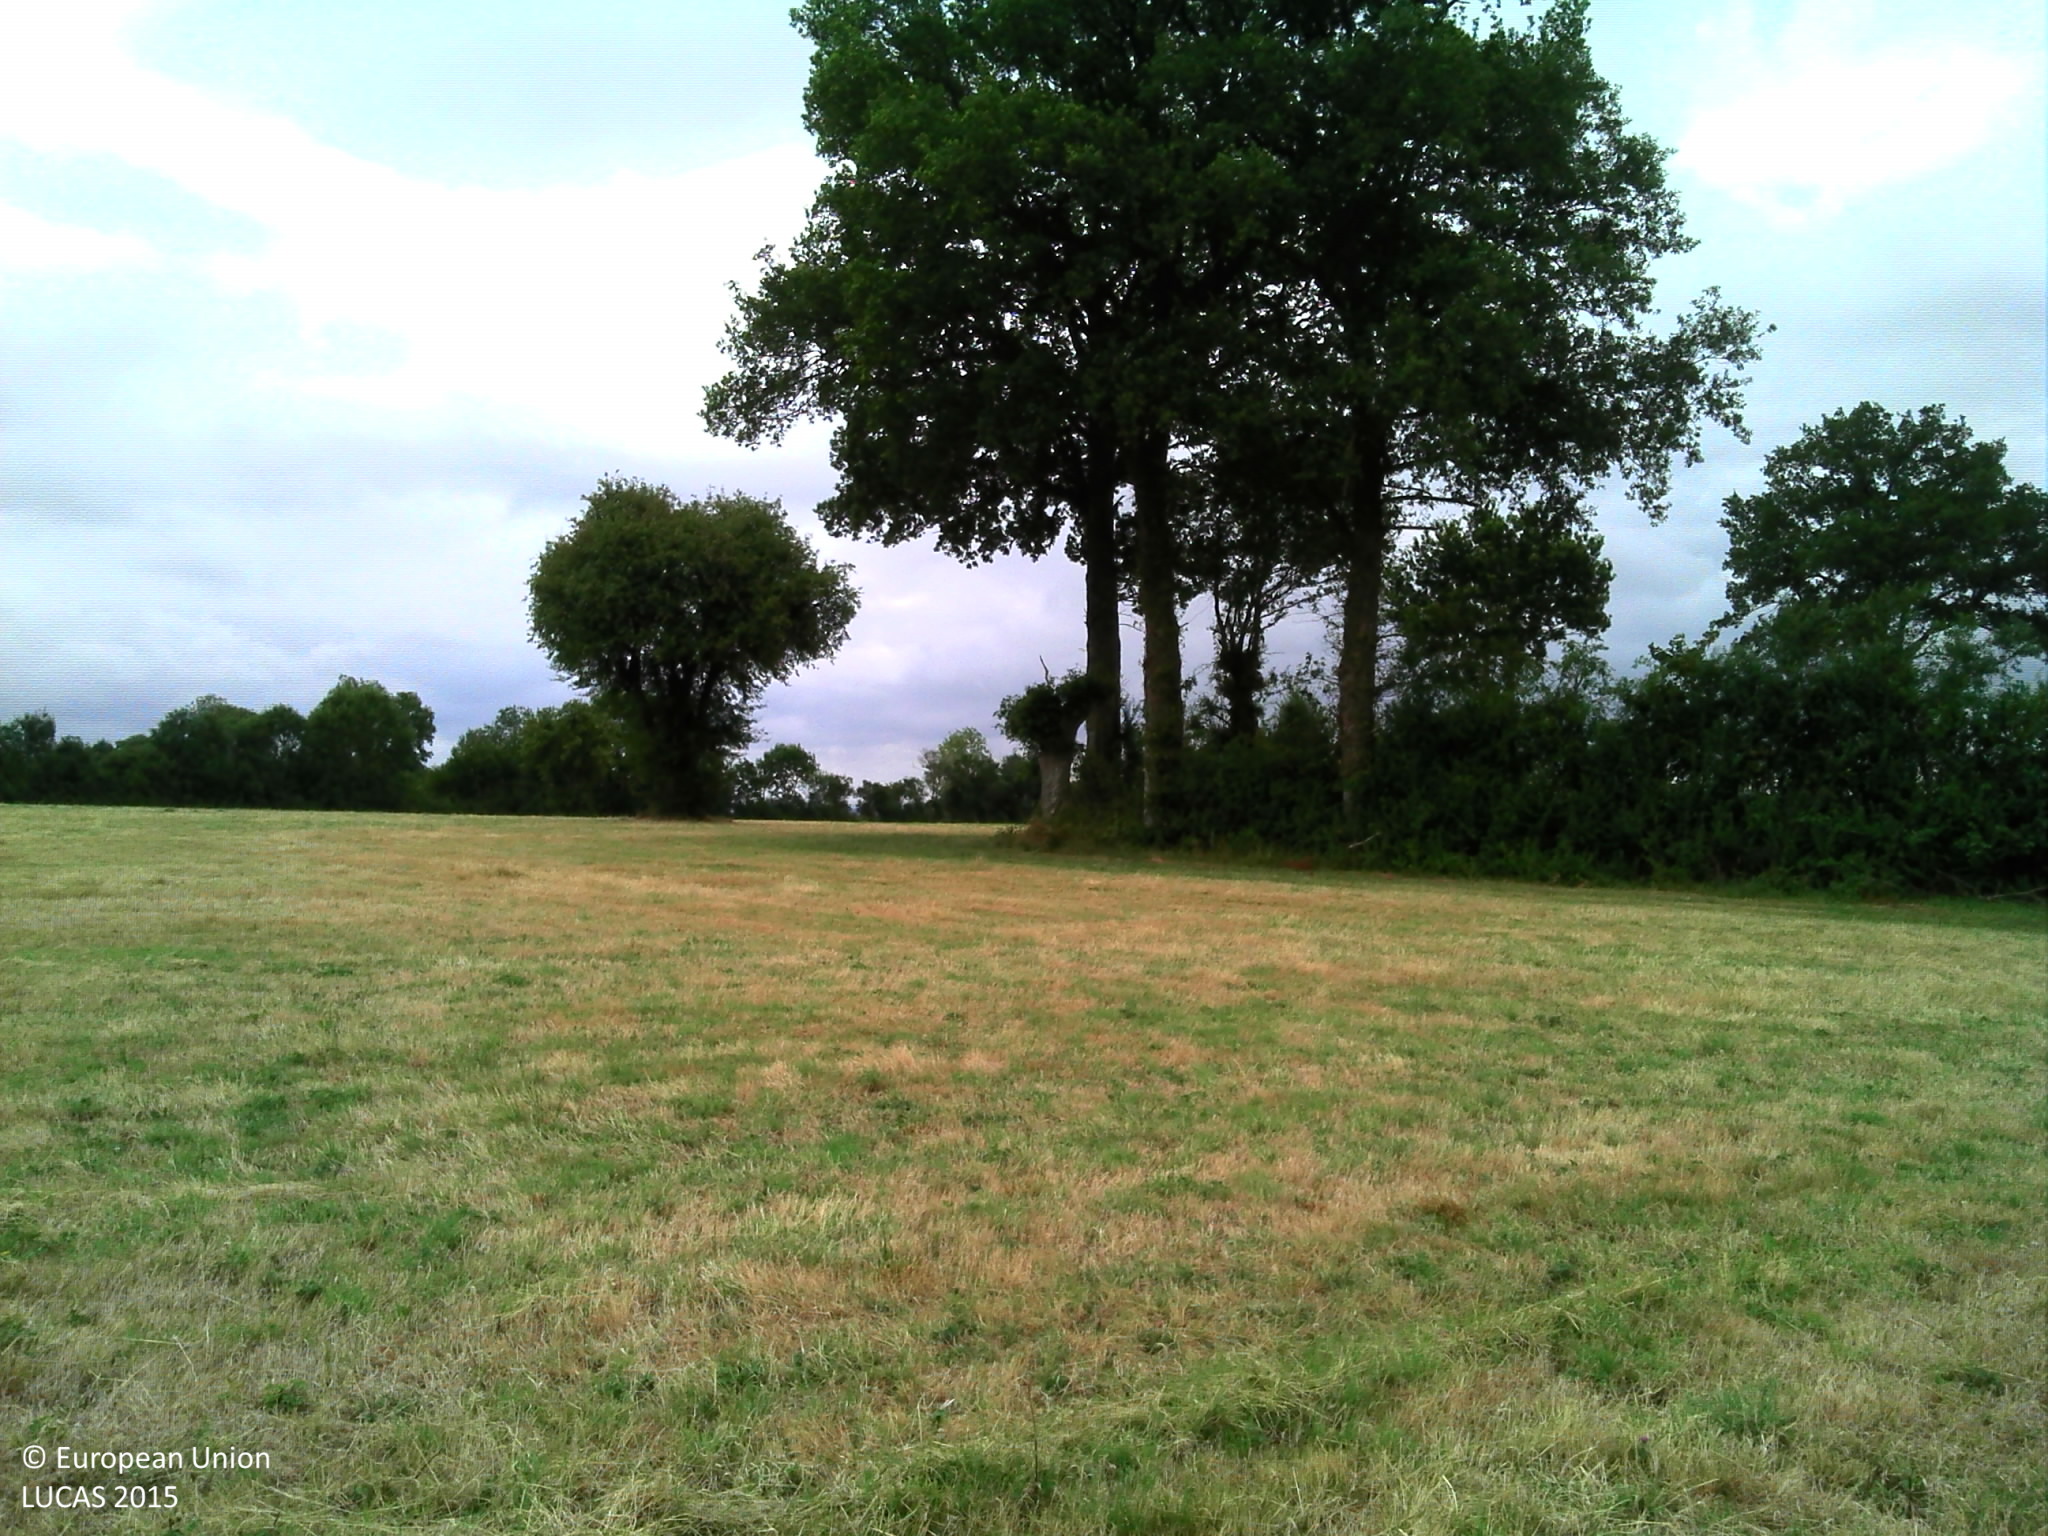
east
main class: Grassland
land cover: Grassland without tree/shrub cover
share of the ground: > 75 %
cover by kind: herbaceous plants 100 %
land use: Agriculture (excluding fallow land and kitchen gardens)
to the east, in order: Grassland without tree/shrub cover; Single bushes/trees; Grassland without tree/shrub cover; Fences; Managed hedges; Rivers and streams; Managed hedges; Grass margins; Managed hedges; Spontaneously vegetated surfaces; Lines of trees; Common wheat
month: July
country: FR
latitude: 48.4270
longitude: -0.1258
